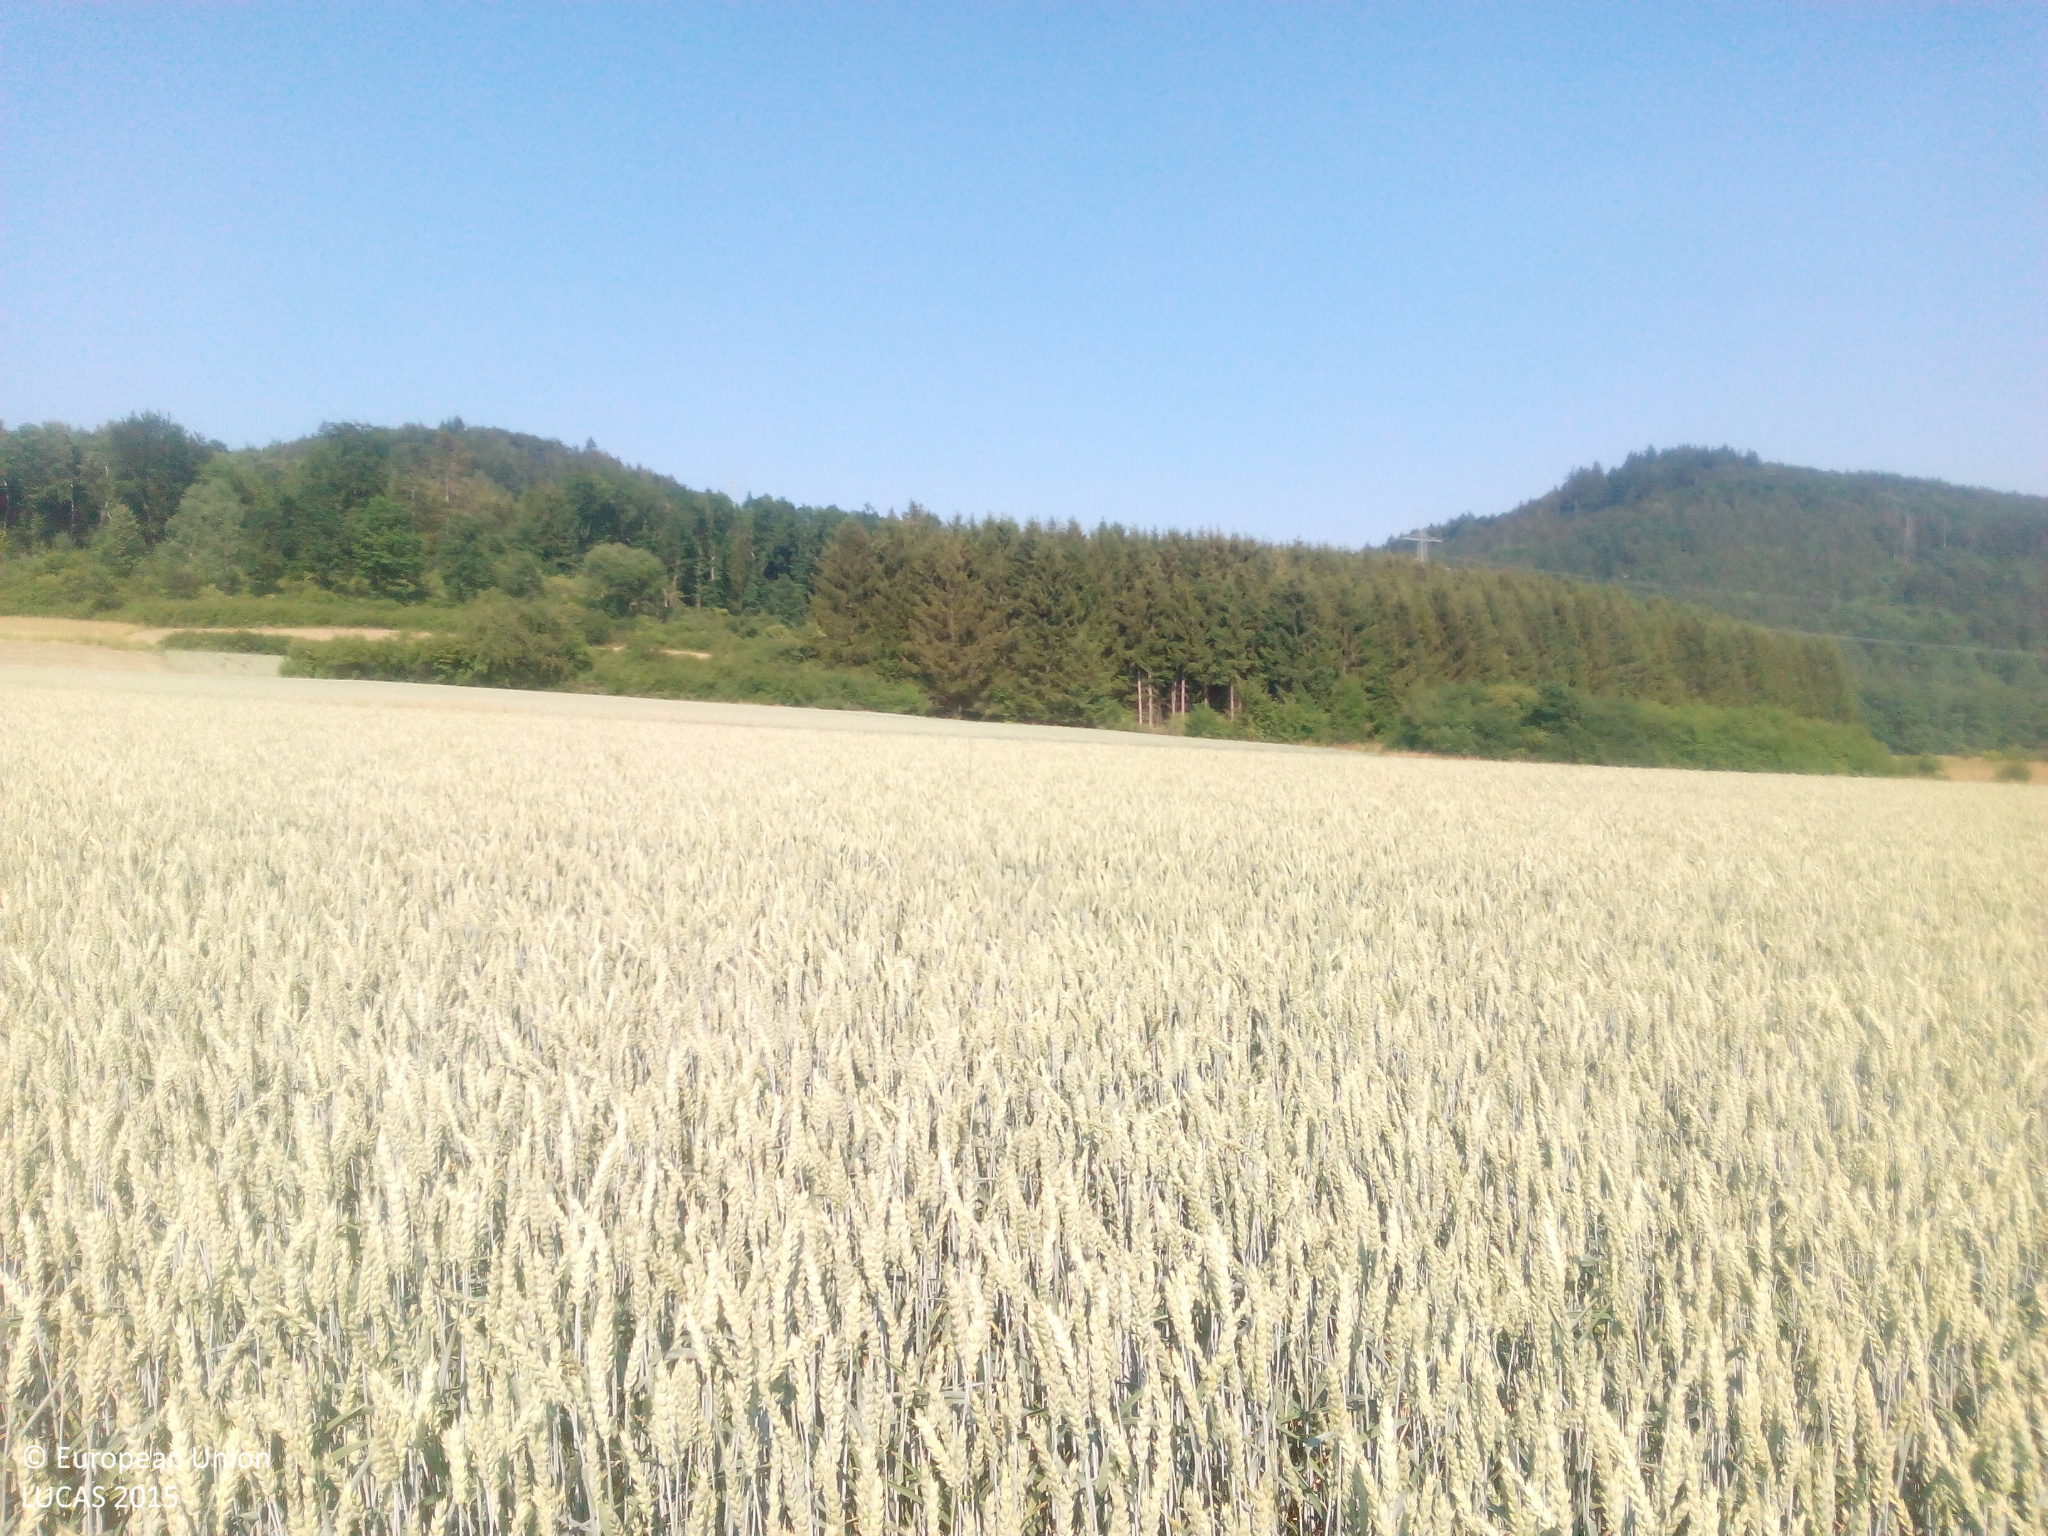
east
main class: Cropland
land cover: Common wheat
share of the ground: > 75 %
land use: Agriculture (excluding fallow land and kitchen gardens)
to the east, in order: Common wheat; Grassland without tree/shrub cover; Common wheat; Grass margins; Shrubland with sparse tree cover; Spruce dominated coniferous woodland; Grass margins; Paved roads, cycling and walking lanes; Grass margins; Shrubland with sparse tree cover
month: July
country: DE
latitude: 50.1561
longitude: 11.5252
